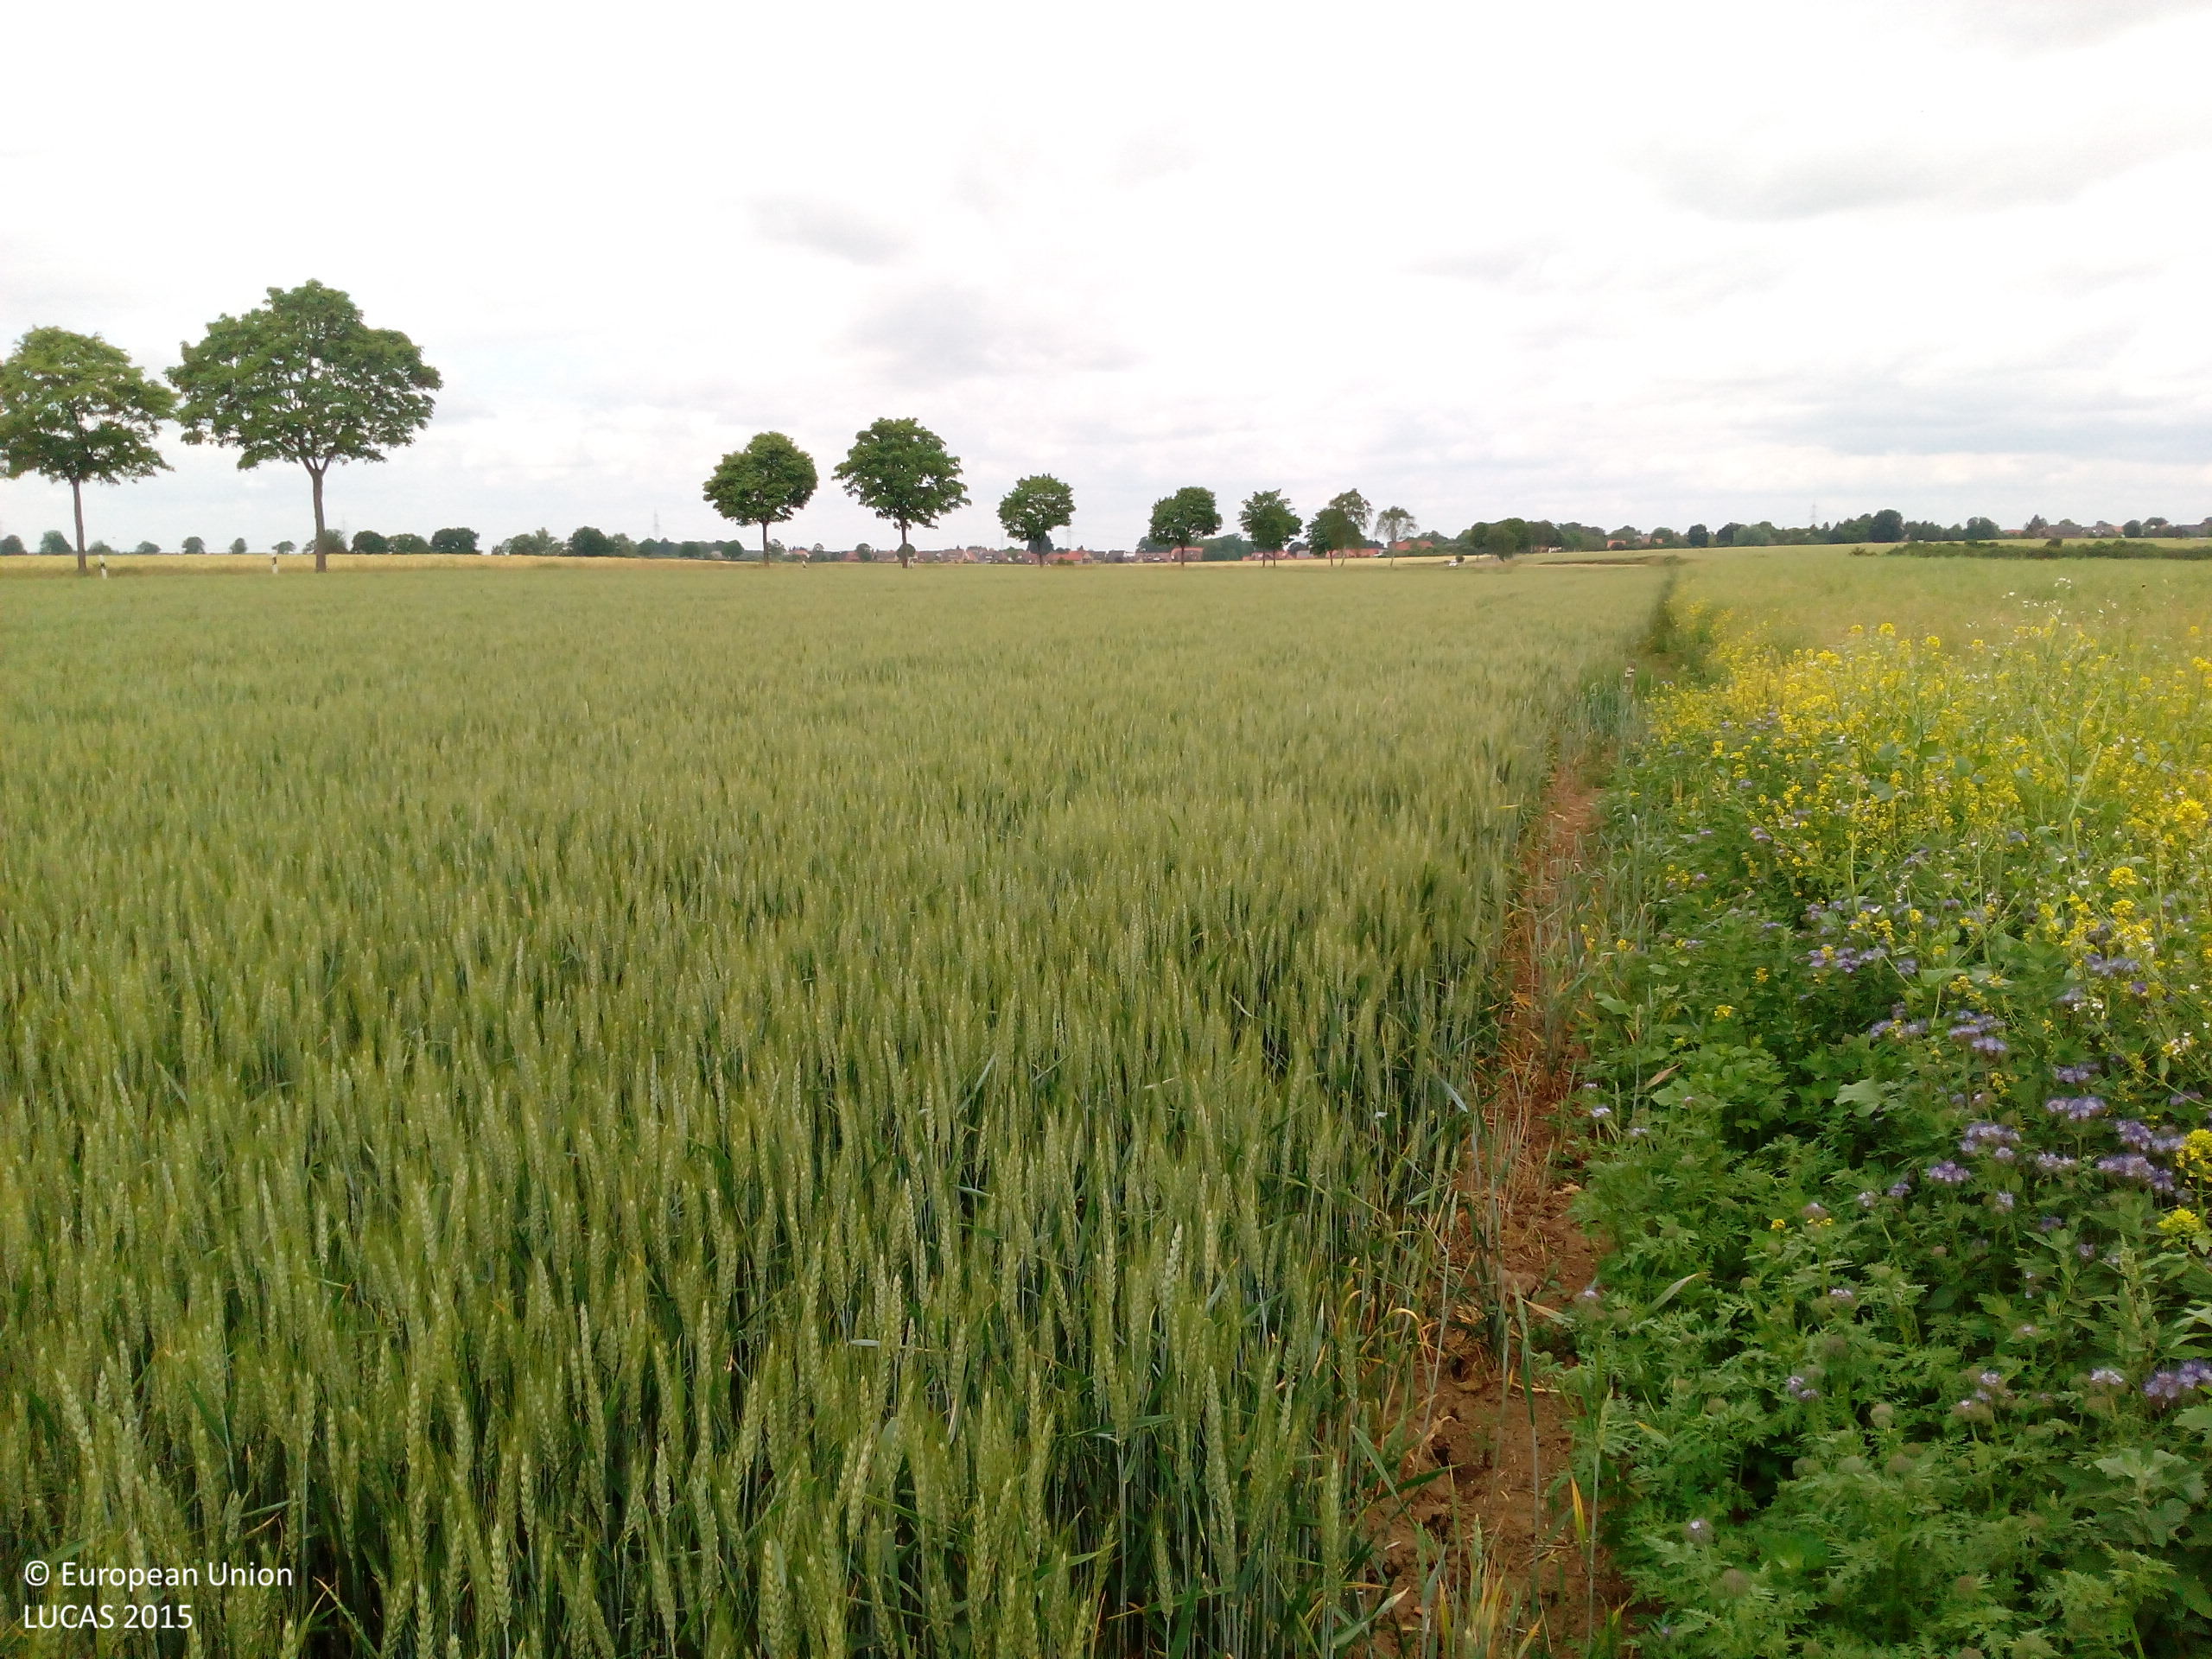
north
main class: Cropland
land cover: Other fibre and oleaginous crops
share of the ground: > 75 %
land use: Agriculture (excluding fallow land and kitchen gardens)
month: June
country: DE
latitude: 52.3578
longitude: 10.6312
